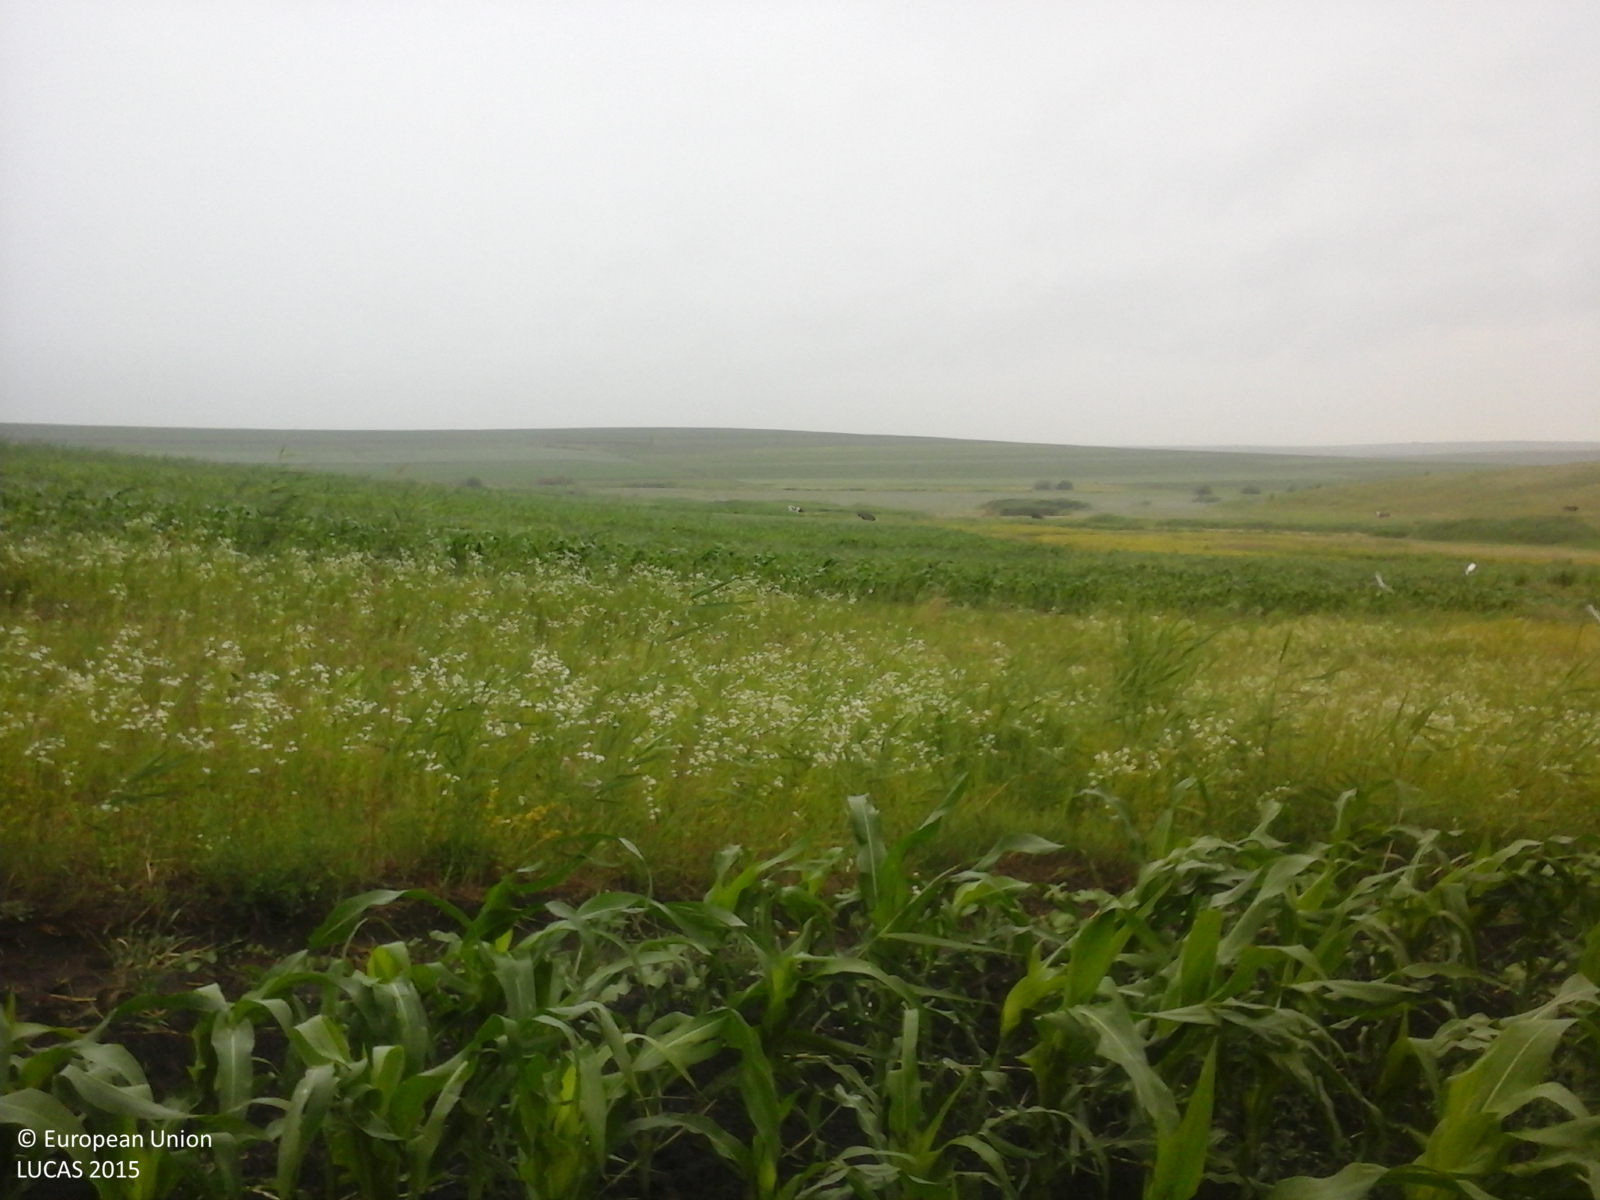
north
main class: Cropland
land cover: Maize
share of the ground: > 75 %
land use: Agriculture (excluding fallow land and kitchen gardens)
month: June
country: RO
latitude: 47.9018
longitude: 26.6432
